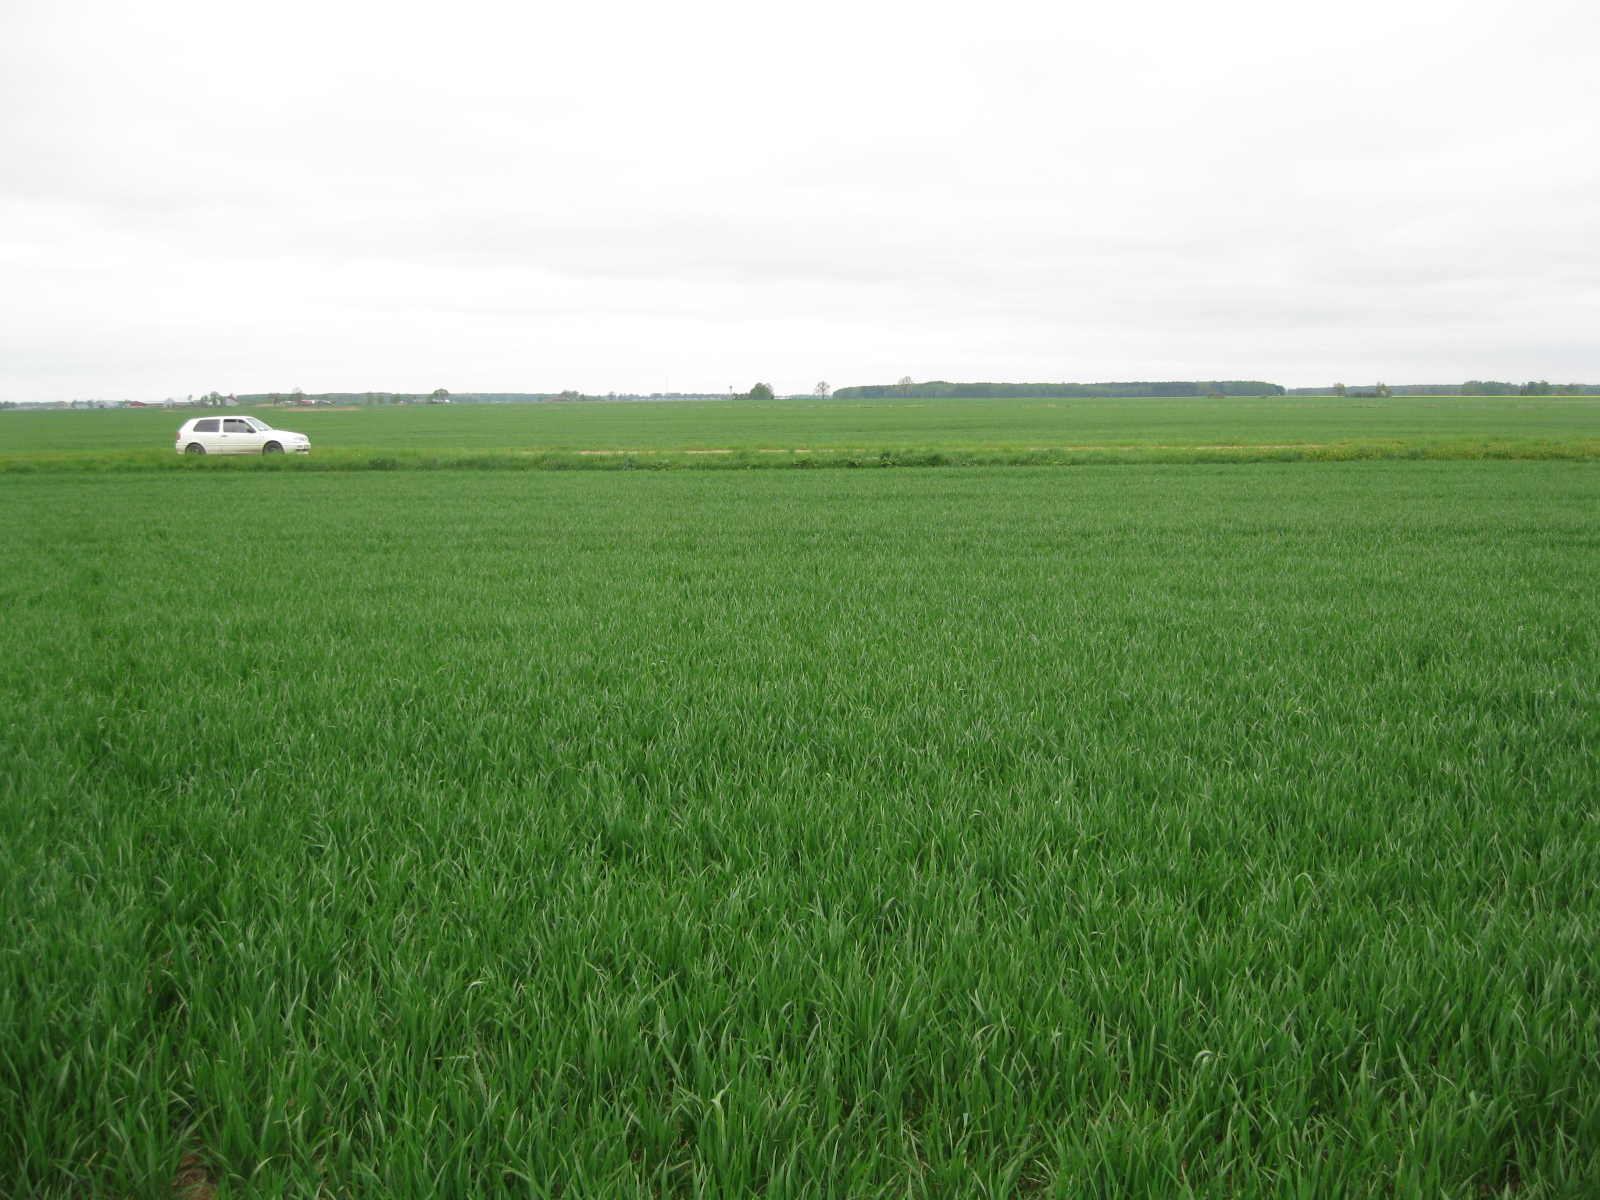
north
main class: Cropland
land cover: Common wheat
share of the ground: > 75 %
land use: Agriculture (excluding fallow land and kitchen gardens)
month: May
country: LT
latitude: 55.9939
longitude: 24.3802
